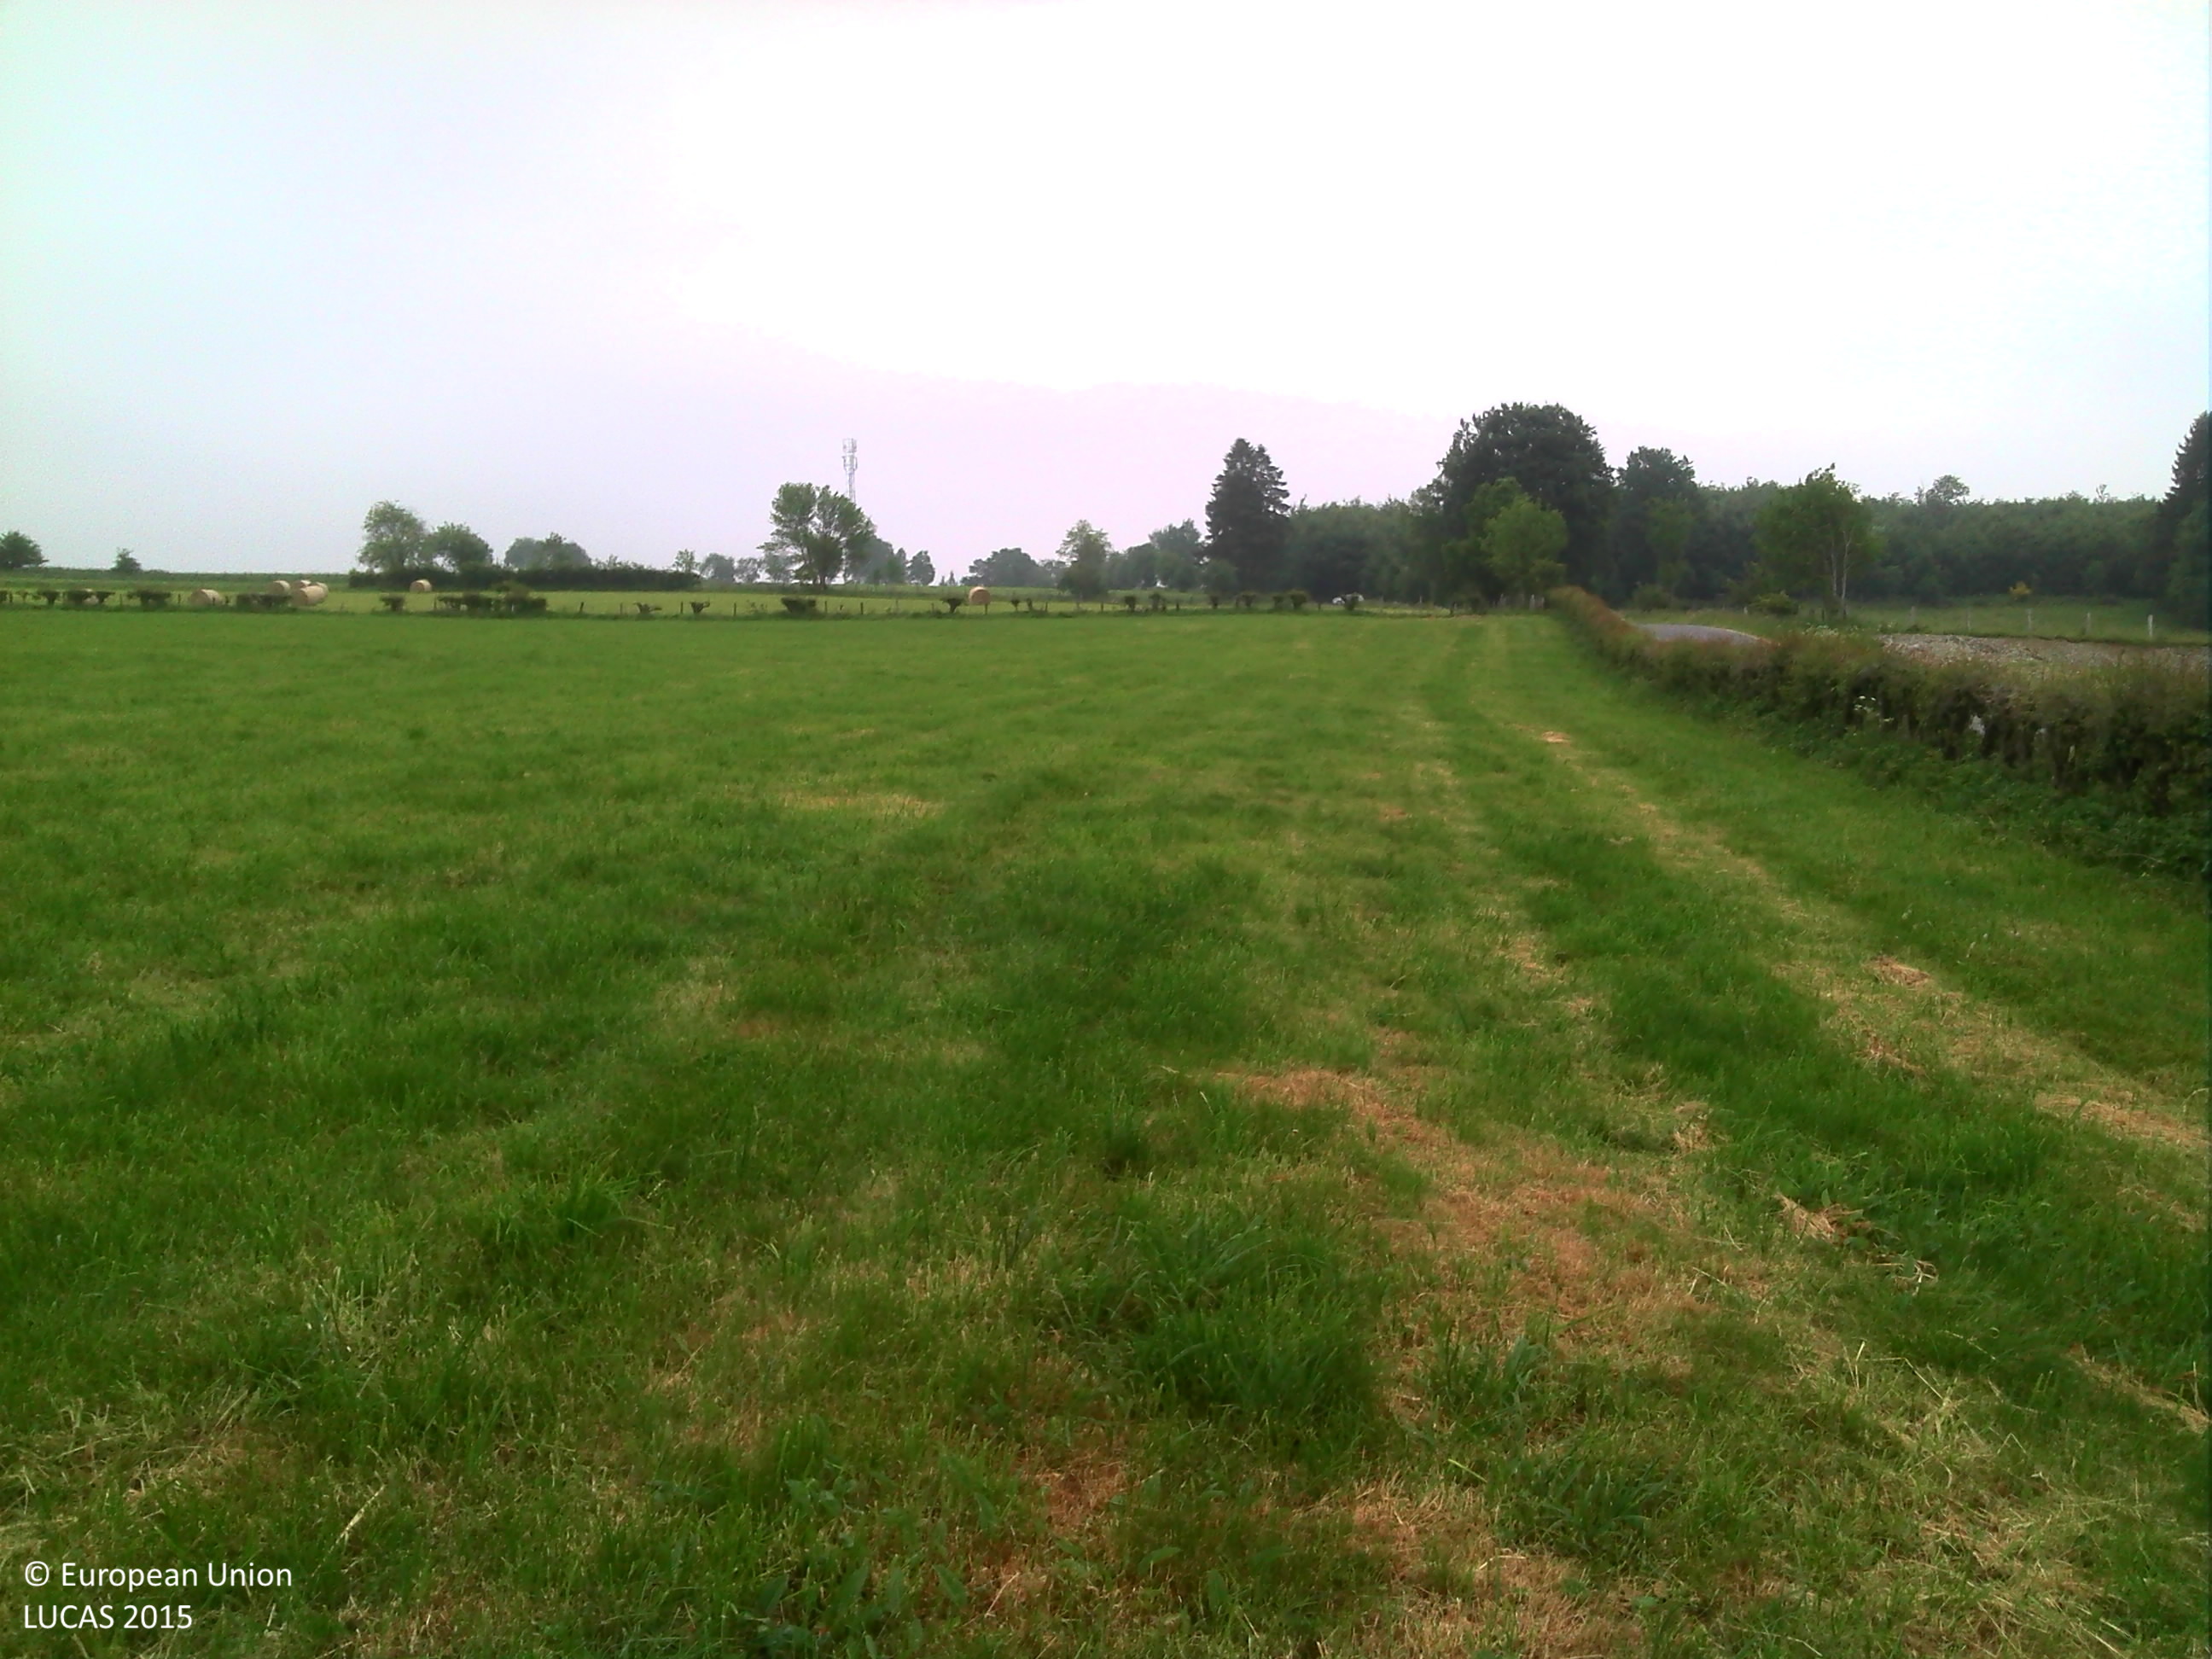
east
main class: Grassland
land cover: Grassland without tree/shrub cover
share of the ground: > 75 %
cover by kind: herbaceous plants 100 %
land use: Agriculture (excluding fallow land and kitchen gardens)
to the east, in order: Grassland without tree/shrub cover; Fences; Grassland without tree/shrub cover; Fences; Managed hedges; Grass margins; Paved roads, cycling and walking lanes; Grass margins; Ditches and canals; Fences; Single bushes/trees; Grassland without tree/shrub cover
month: June
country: BE
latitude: 50.4113
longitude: 6.2703
